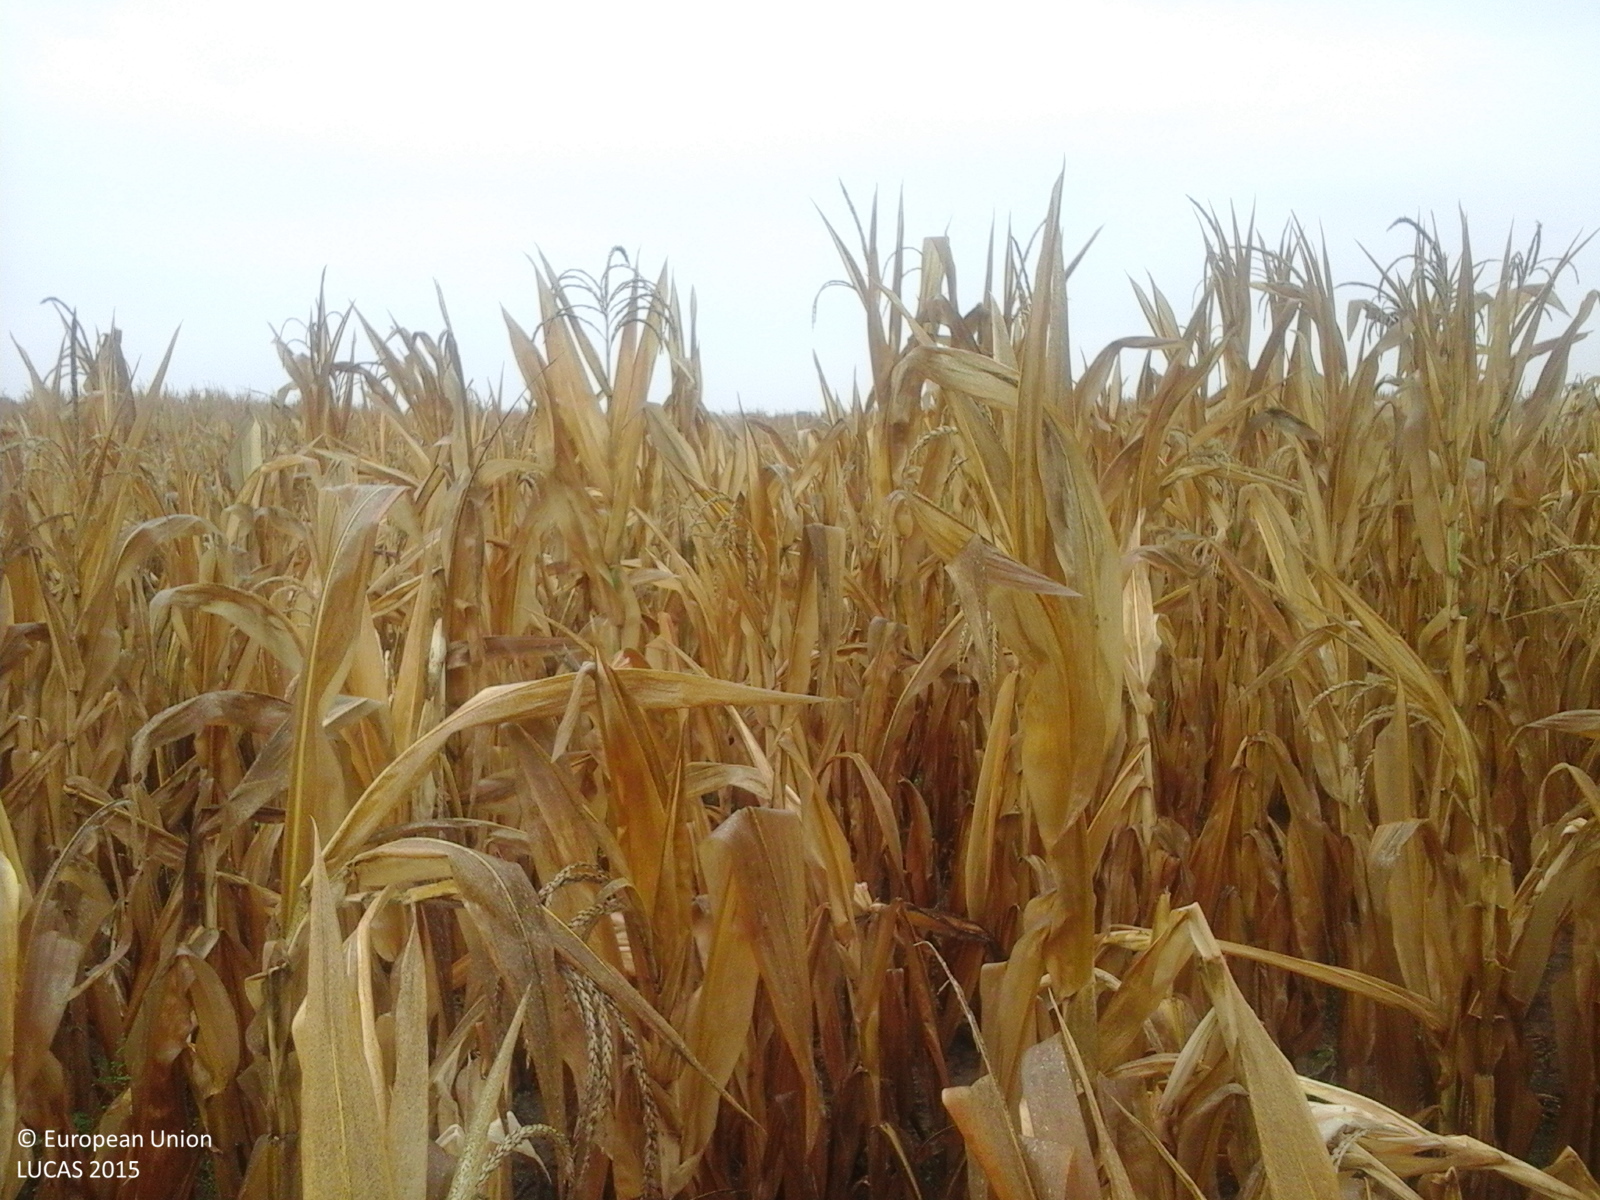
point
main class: Cropland
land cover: Maize
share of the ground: > 75 %
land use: Agriculture (excluding fallow land and kitchen gardens)
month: September
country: RO
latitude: 47.5884
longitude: 22.5985
